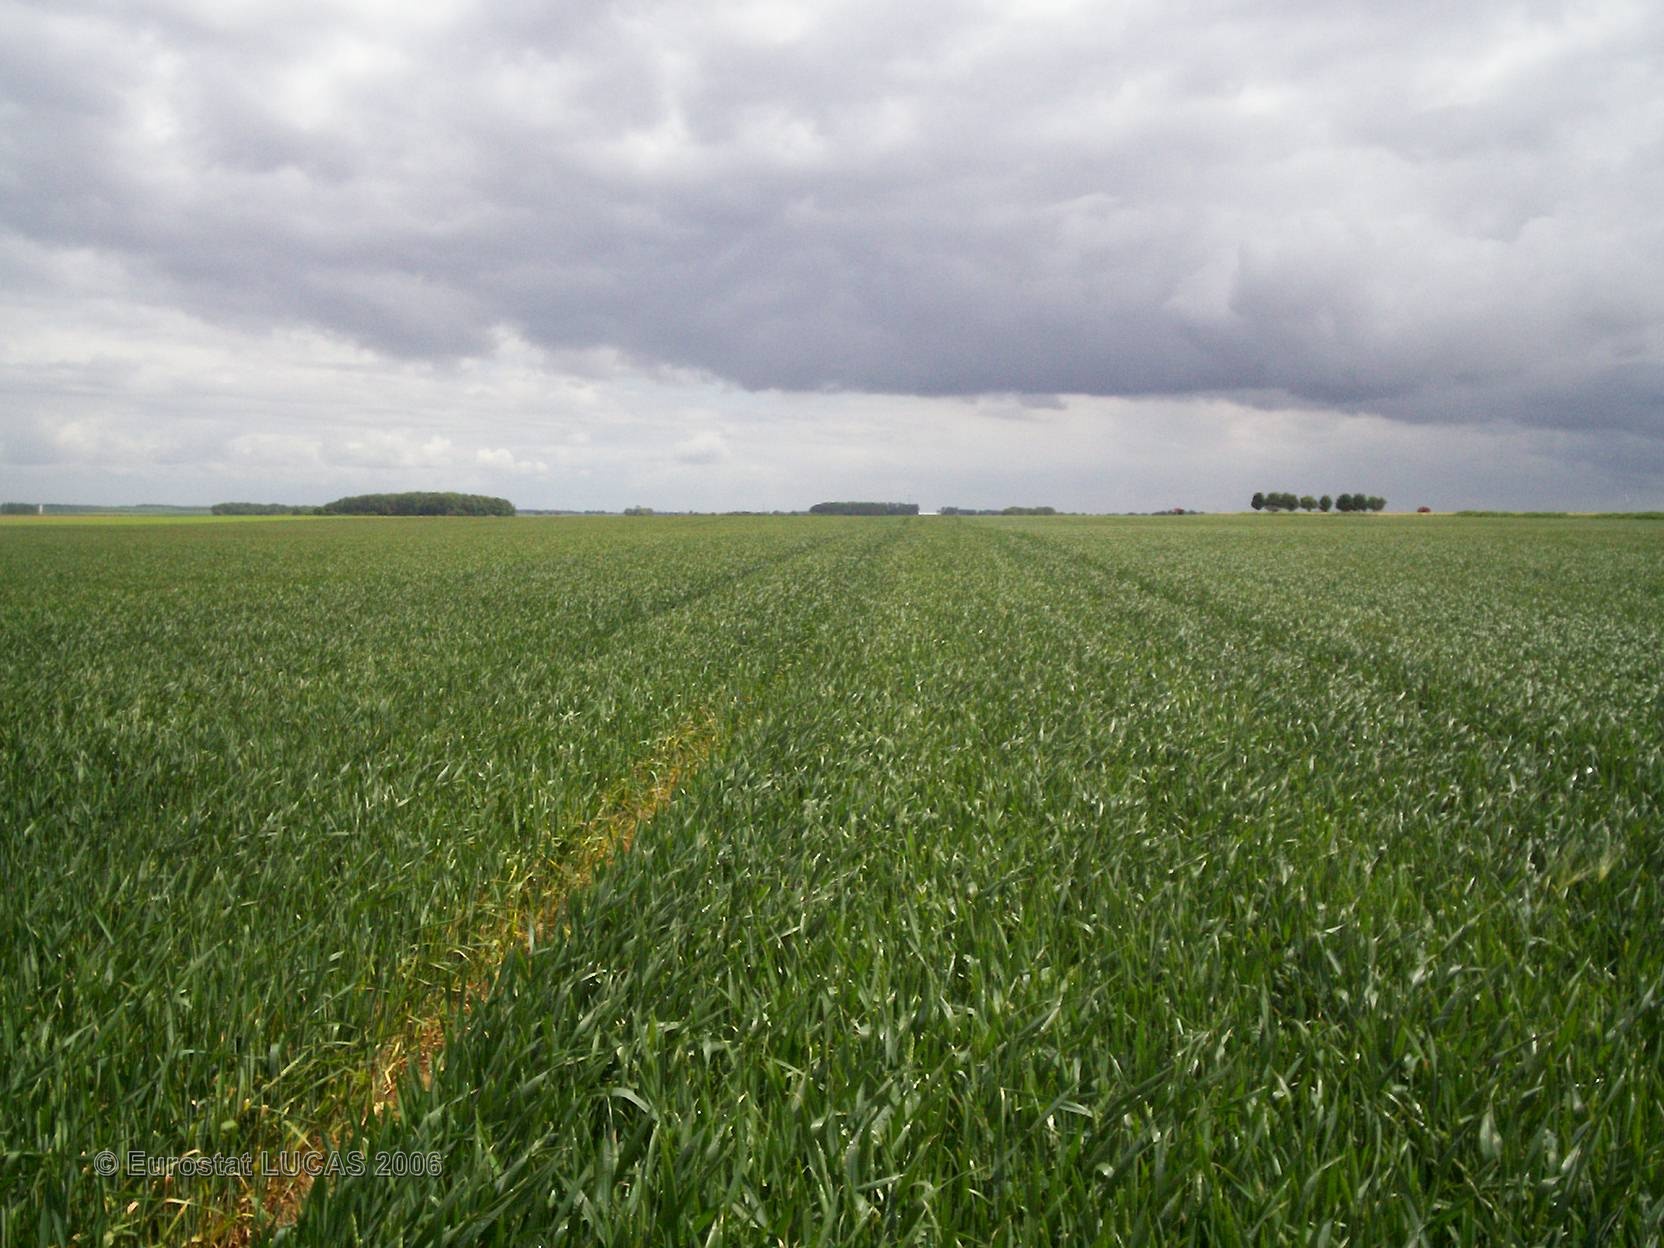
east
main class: Cropland
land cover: Common wheat
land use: Agriculture (excluding fallow land and kitchen gardens)
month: May
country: FR
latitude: 49.8732
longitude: 2.6277
